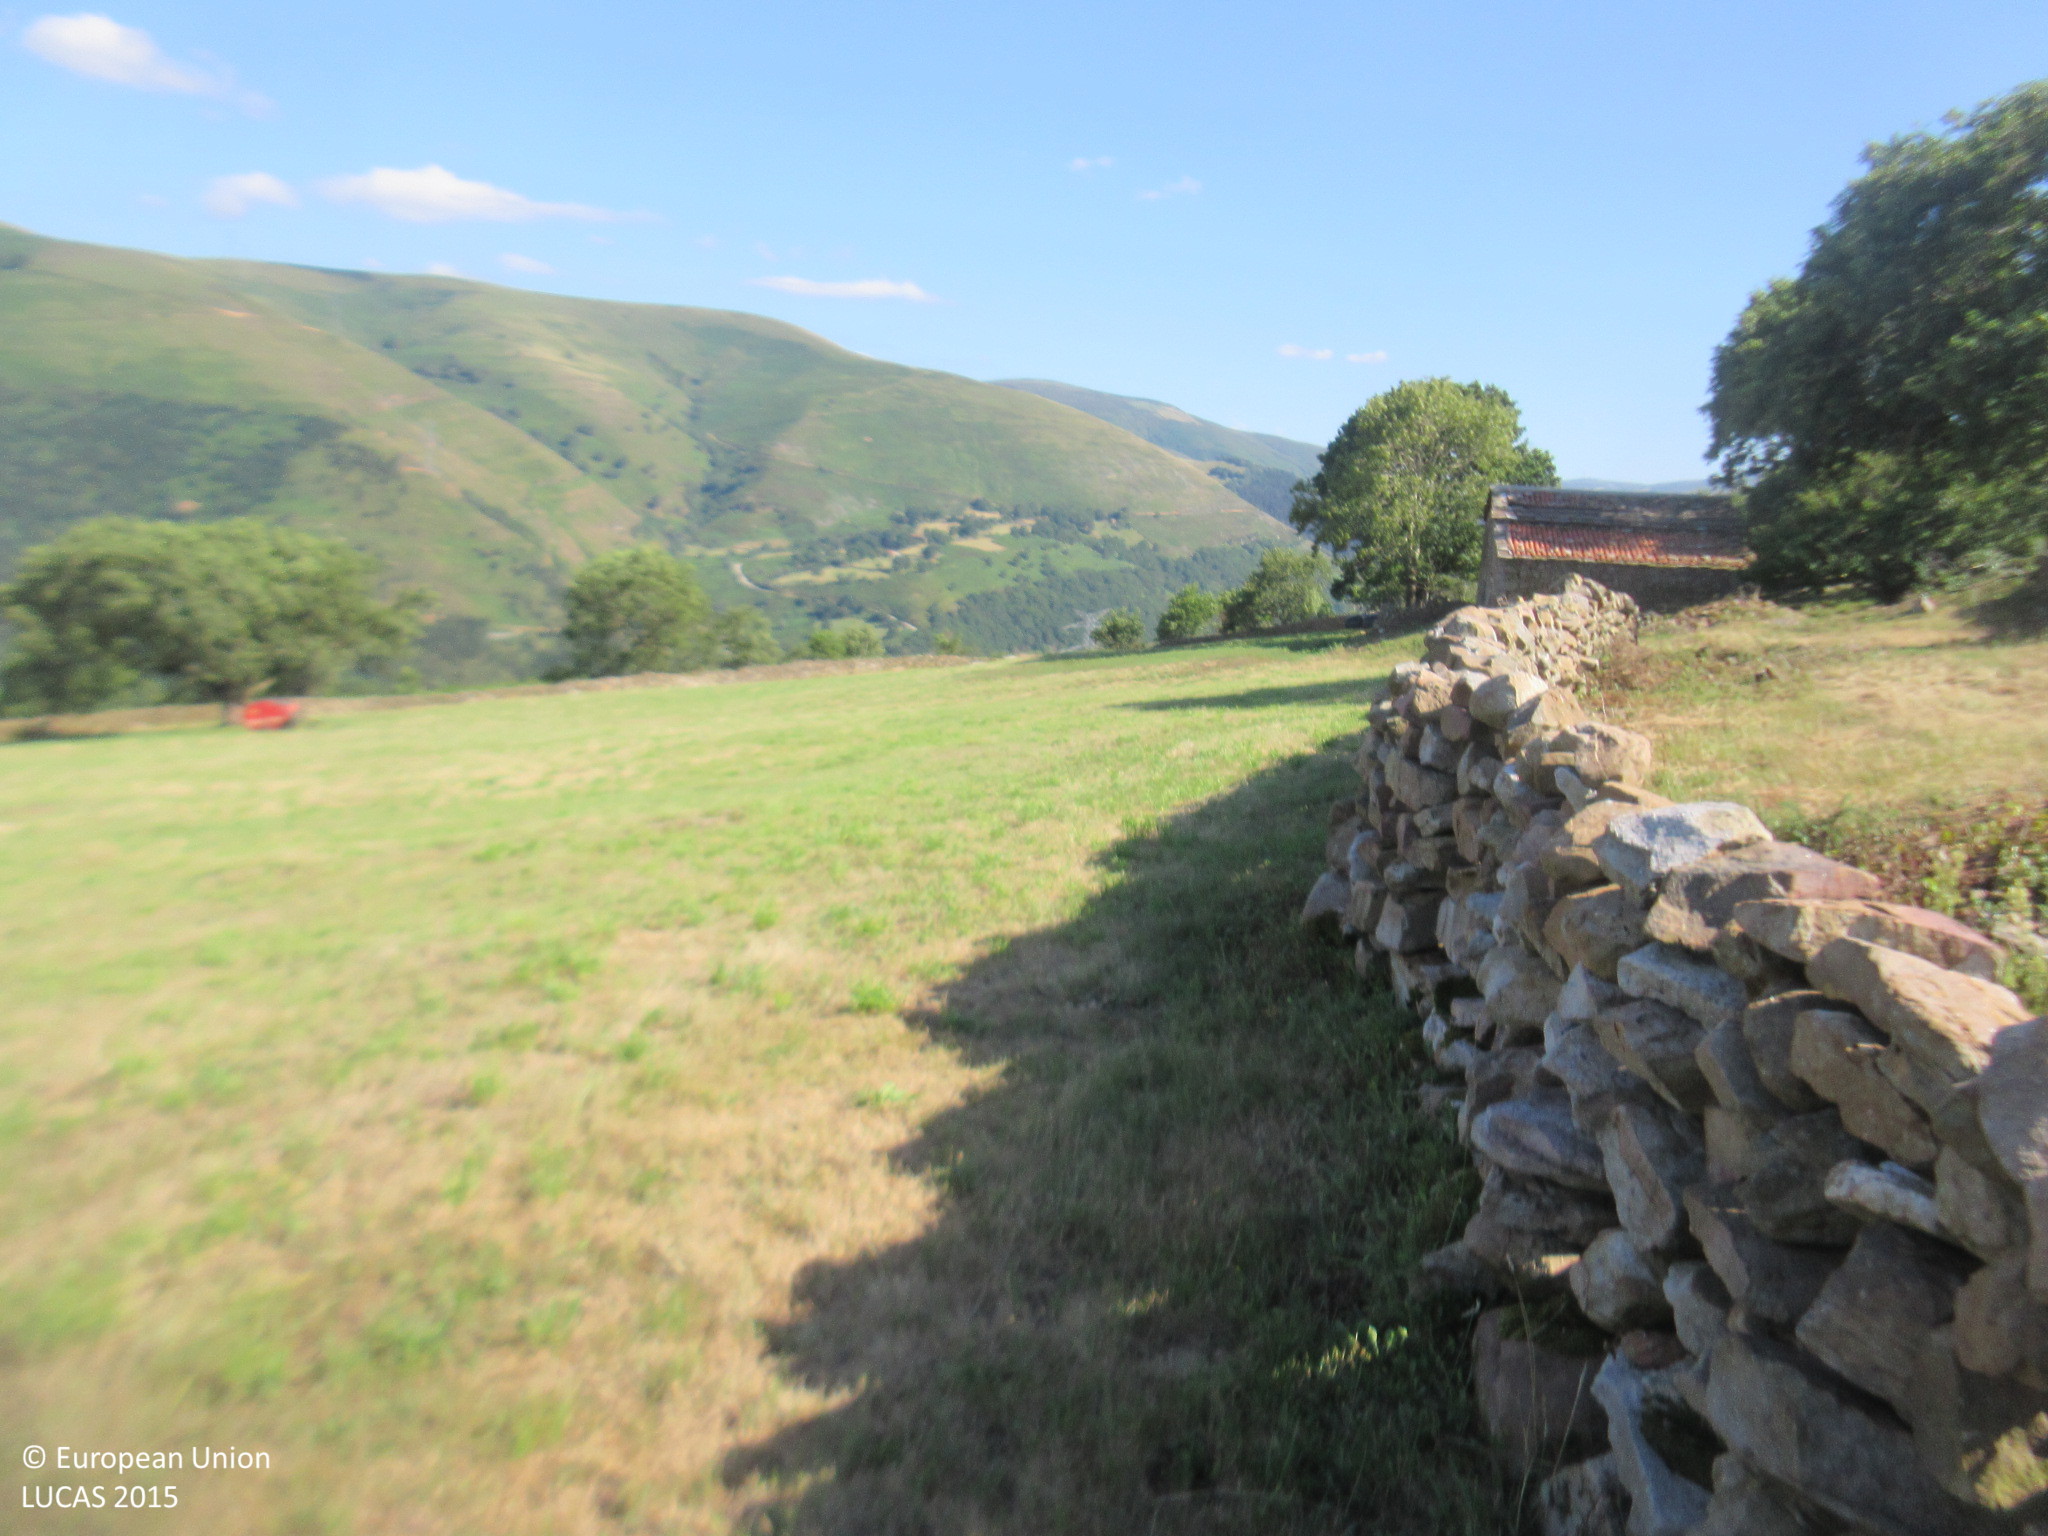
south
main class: Grassland
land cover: Grassland without tree/shrub cover
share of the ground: > 75 %
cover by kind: herbaceous plants 100 %
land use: Agriculture (excluding fallow land and kitchen gardens)
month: July
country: ES
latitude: 43.1529
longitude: -3.9068
